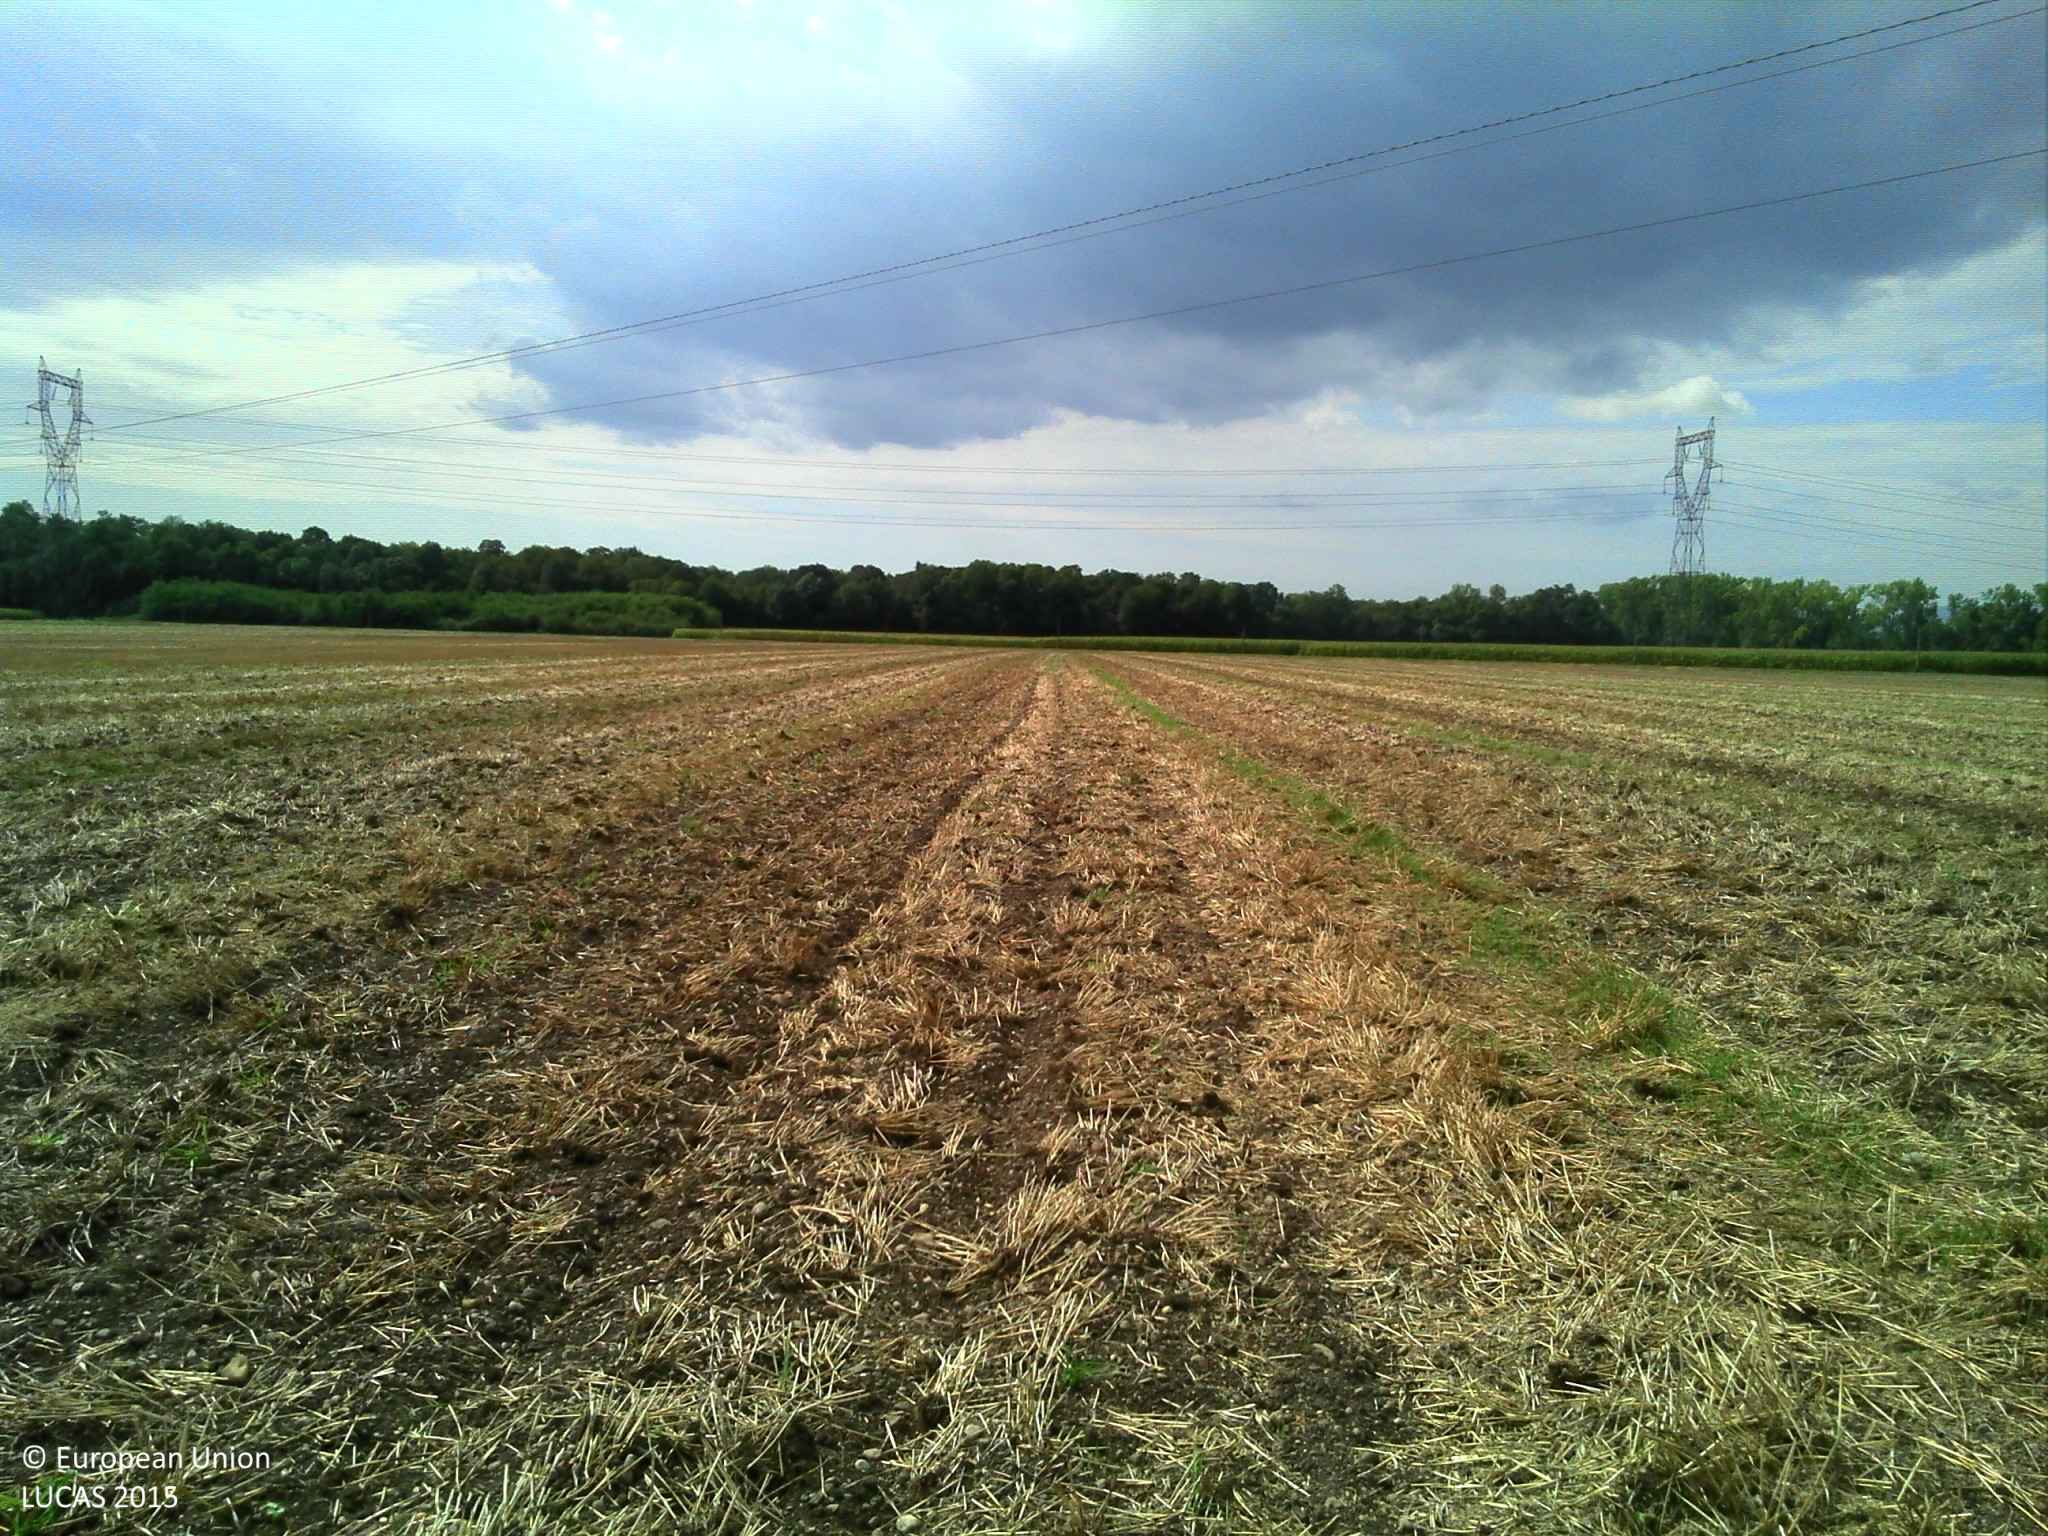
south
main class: Cropland
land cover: Common wheat
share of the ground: 10 - 25 %
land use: Agriculture (excluding fallow land and kitchen gardens)
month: August
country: FR
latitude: 48.0299
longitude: 7.3594
